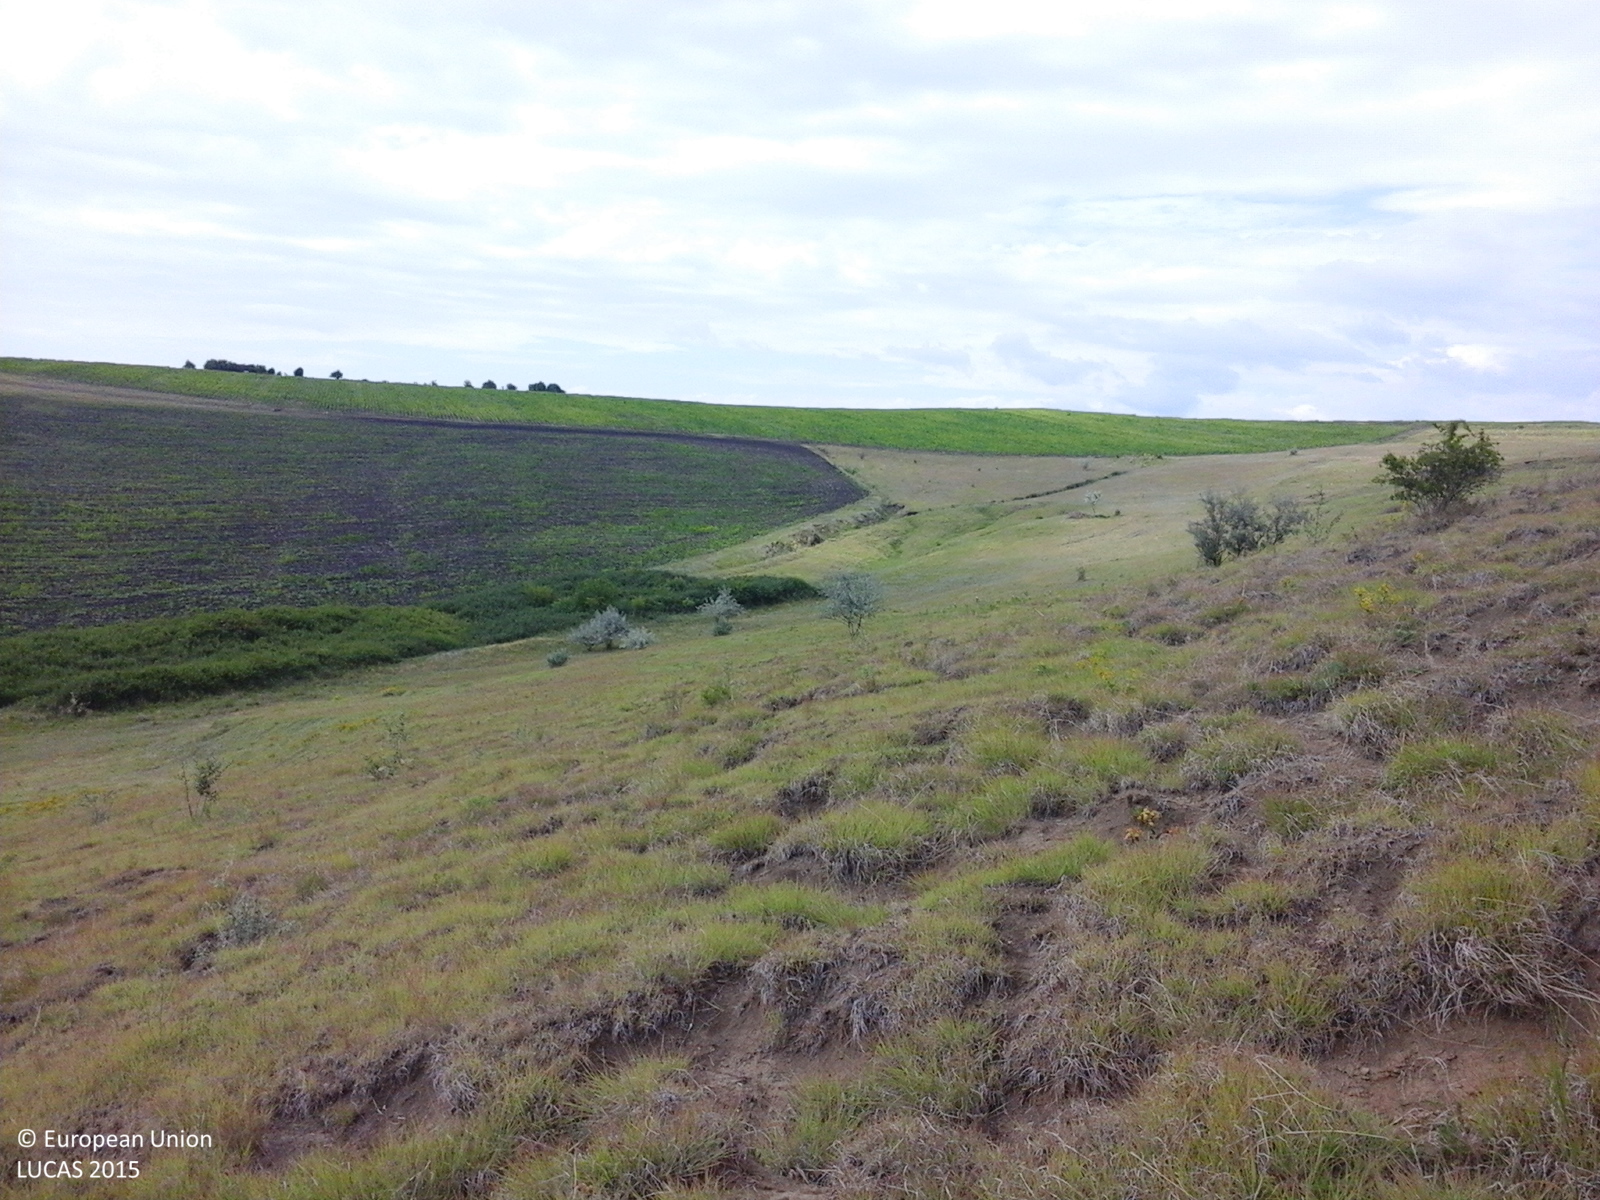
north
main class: Grassland
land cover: Grassland without tree/shrub cover
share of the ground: 50 - 75 %
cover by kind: herbaceous plants 100 %
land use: Agriculture (excluding fallow land and kitchen gardens)
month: June
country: RO
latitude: 46.7048
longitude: 27.6836
